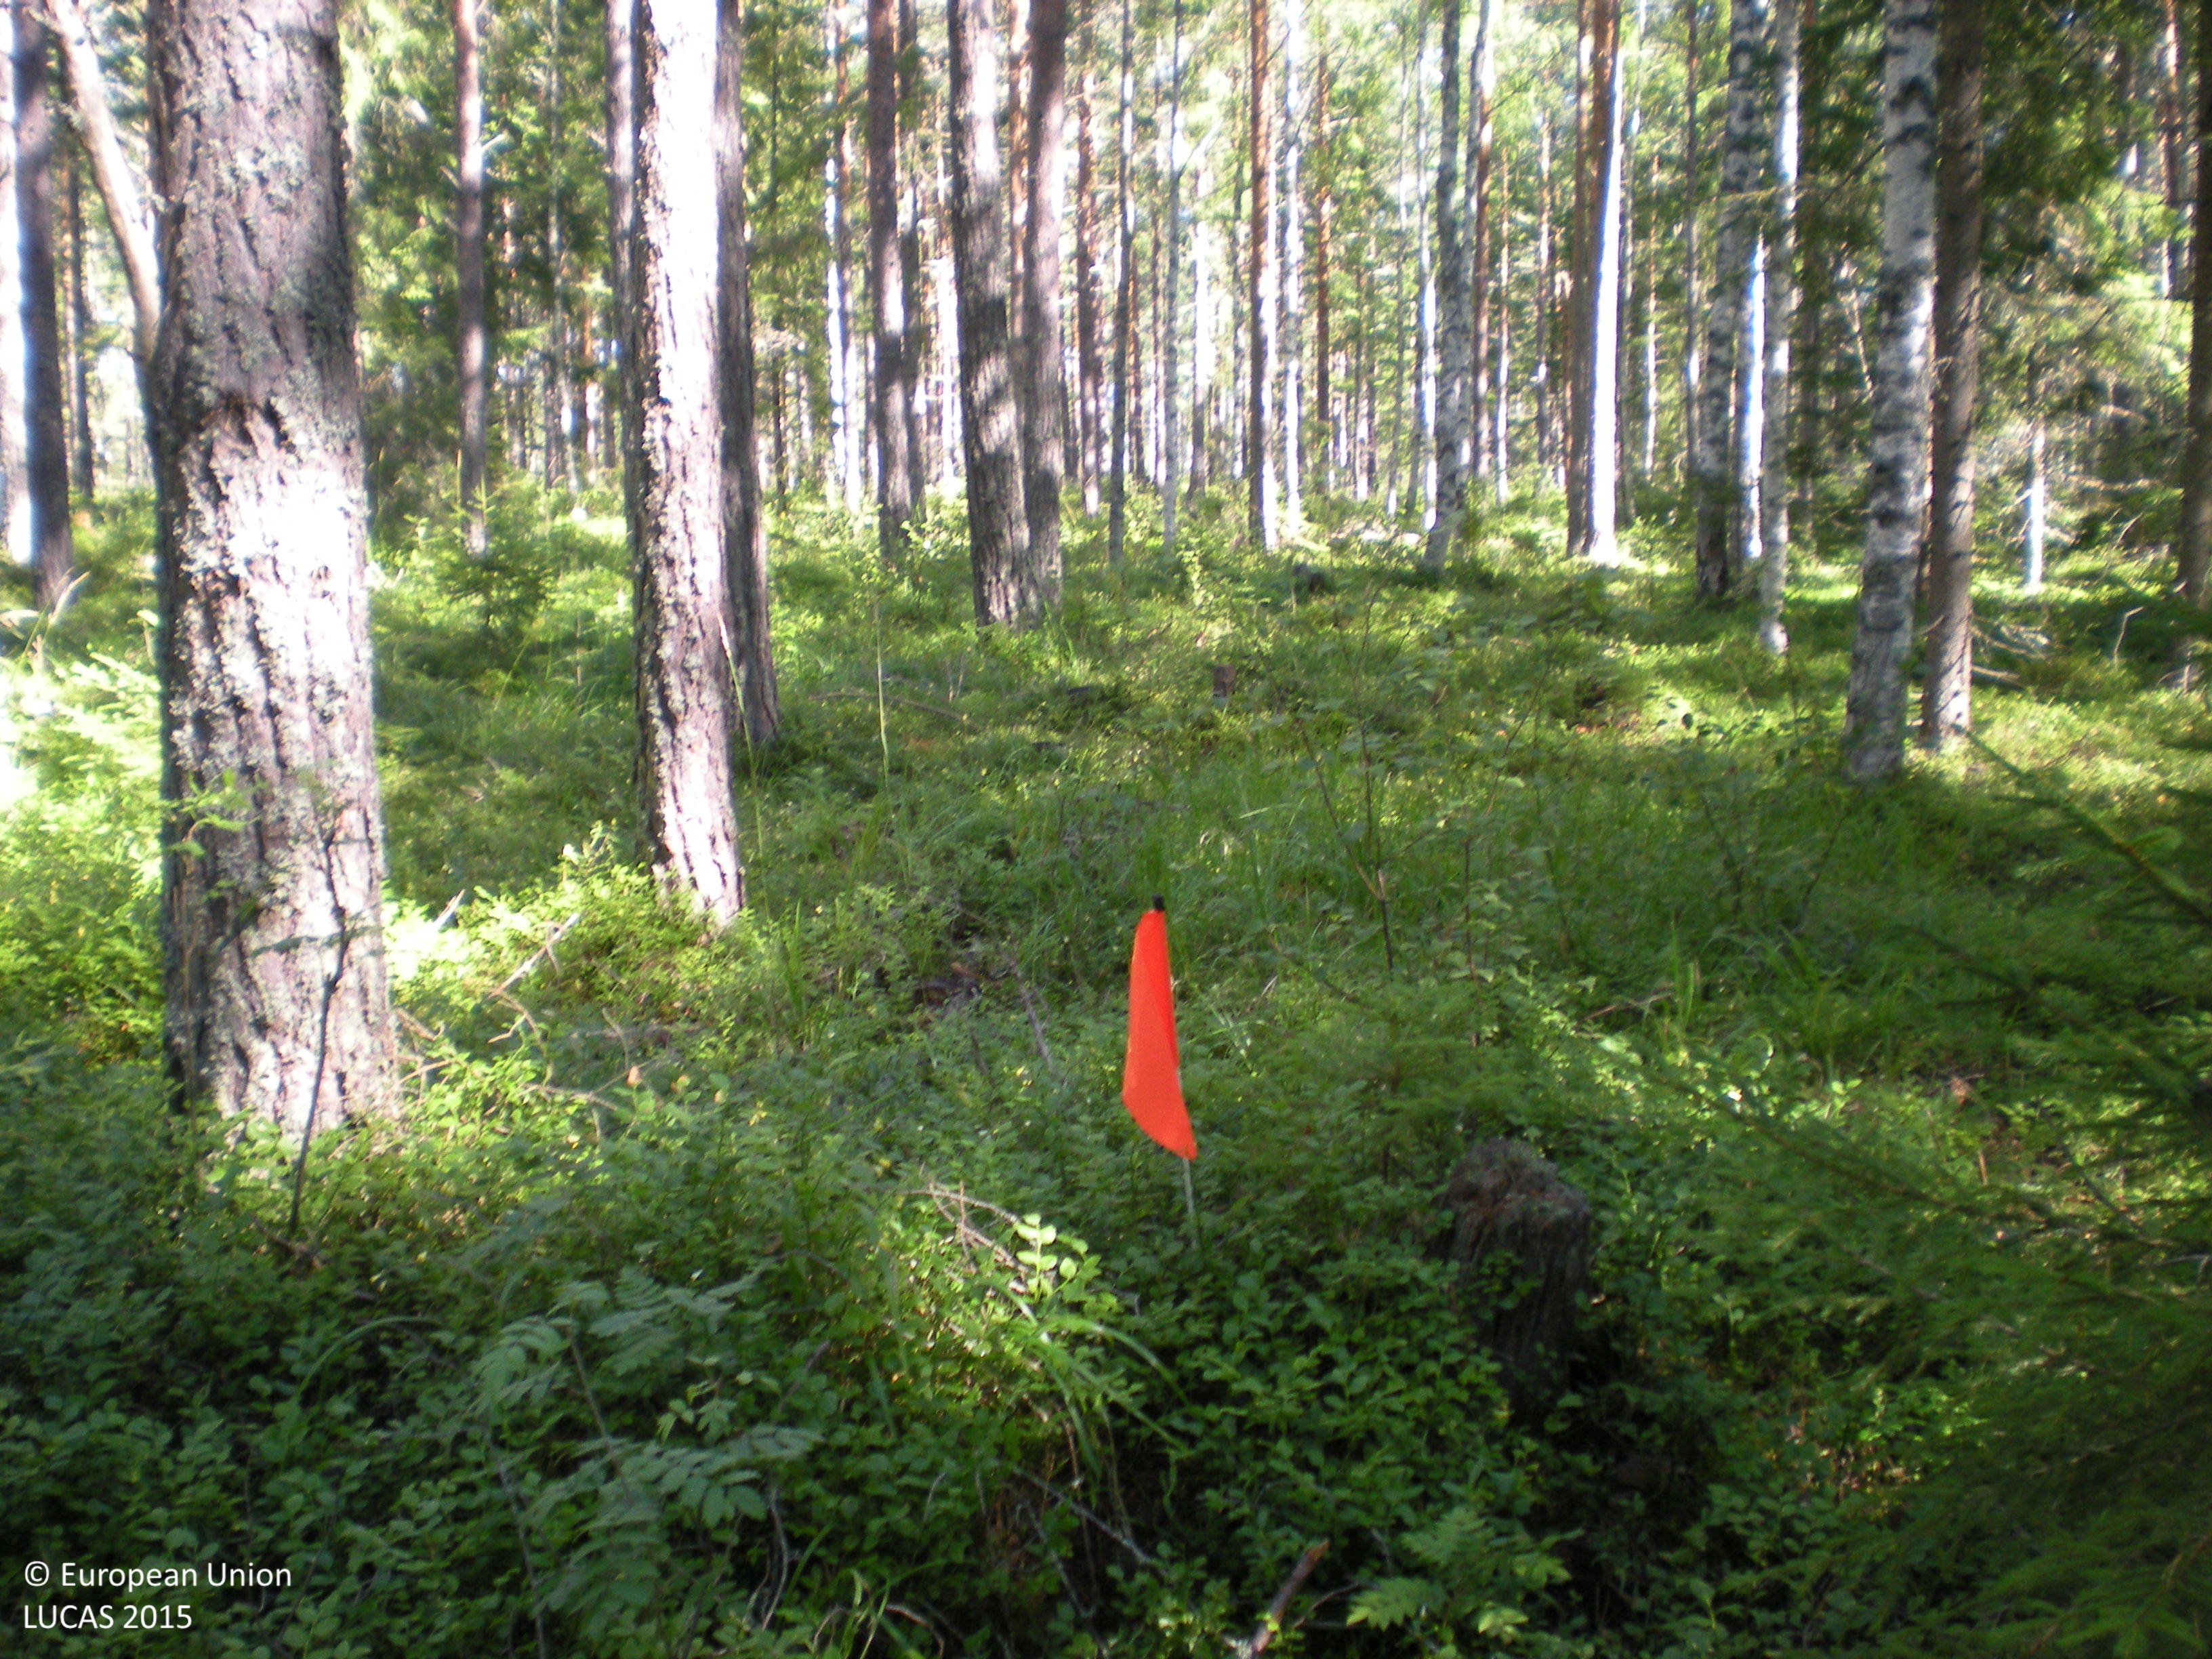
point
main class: Woodland
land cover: Pine dominated coniferous woodland
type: boreal forest
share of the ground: 50 - 75 %
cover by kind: coniferous forest trees 60 %, shrubs 20 %, broadleaved forest trees 10 %, herbaceous plants 5 %, lichens and mosses 5 %
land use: Forestry
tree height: > 5 m
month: August
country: SE
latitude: 60.7601
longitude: 17.1278
